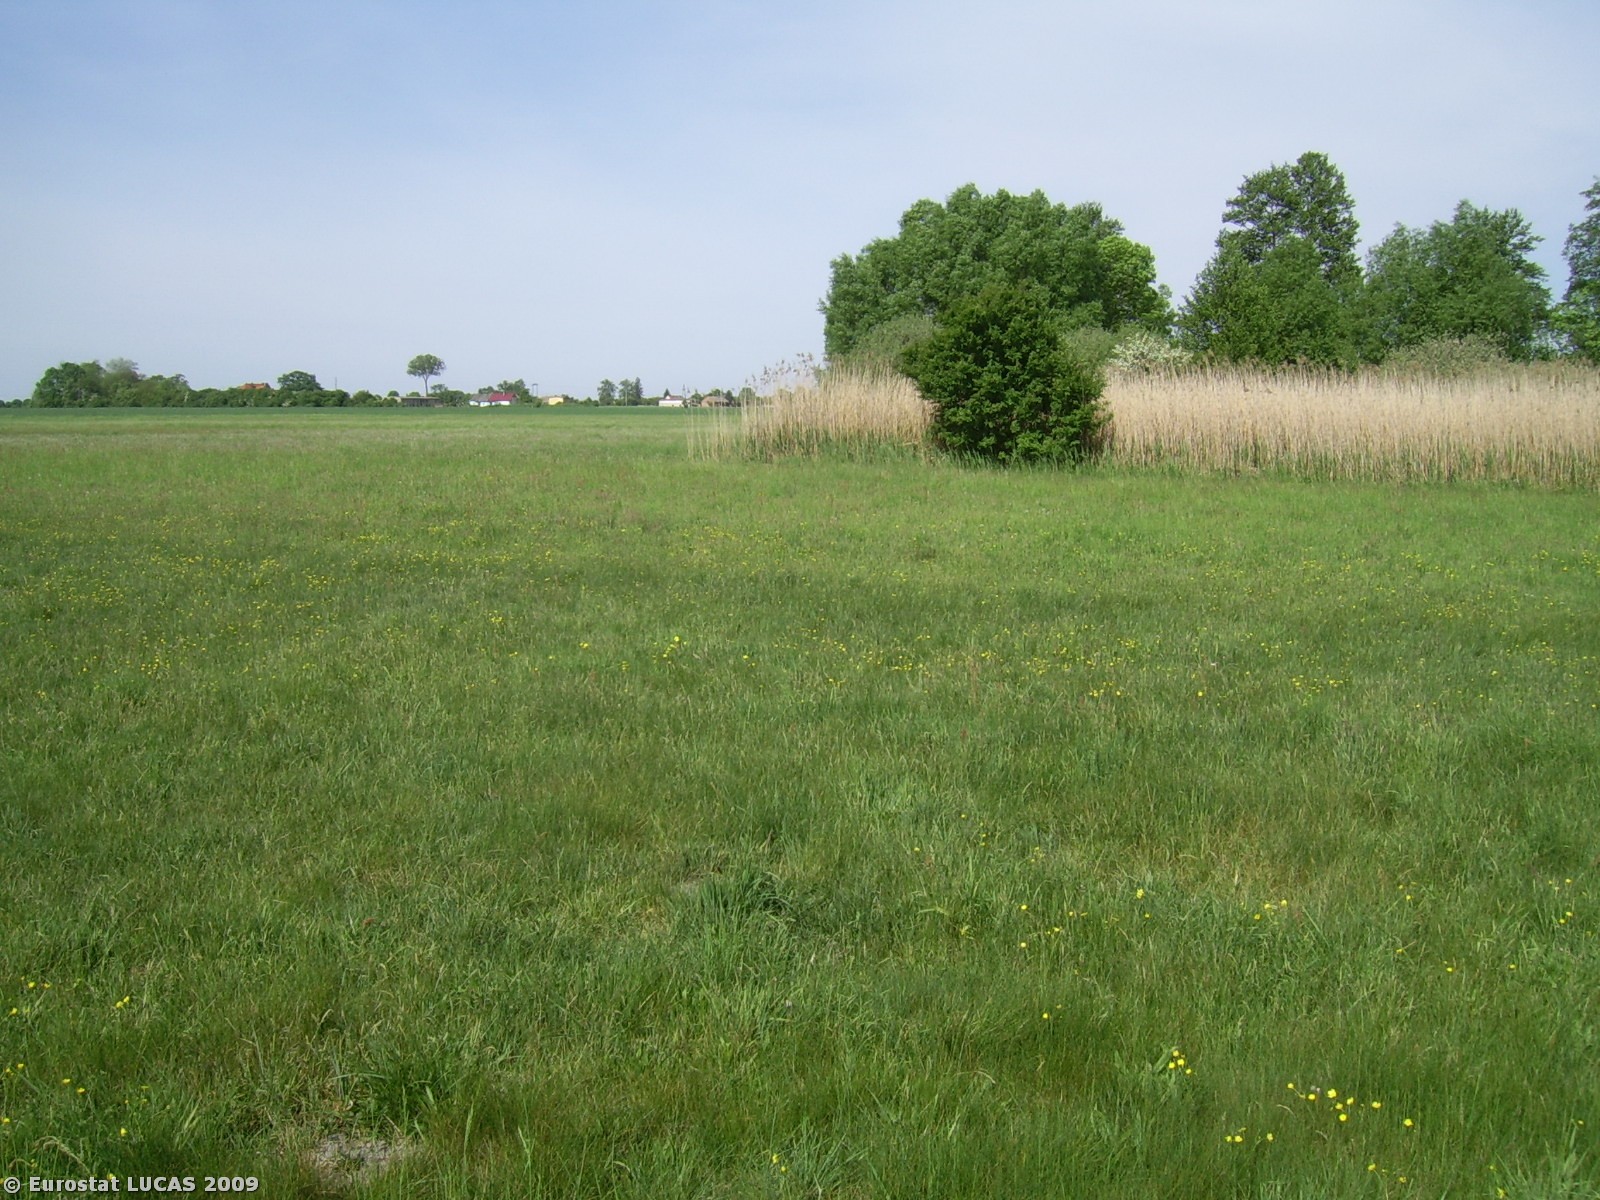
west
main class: Grassland
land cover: Grassland without tree/shrub cover
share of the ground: > 75 %
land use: Agriculture (excluding fallow land and kitchen gardens)
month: May
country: PL
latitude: 52.0142
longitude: 16.9013
